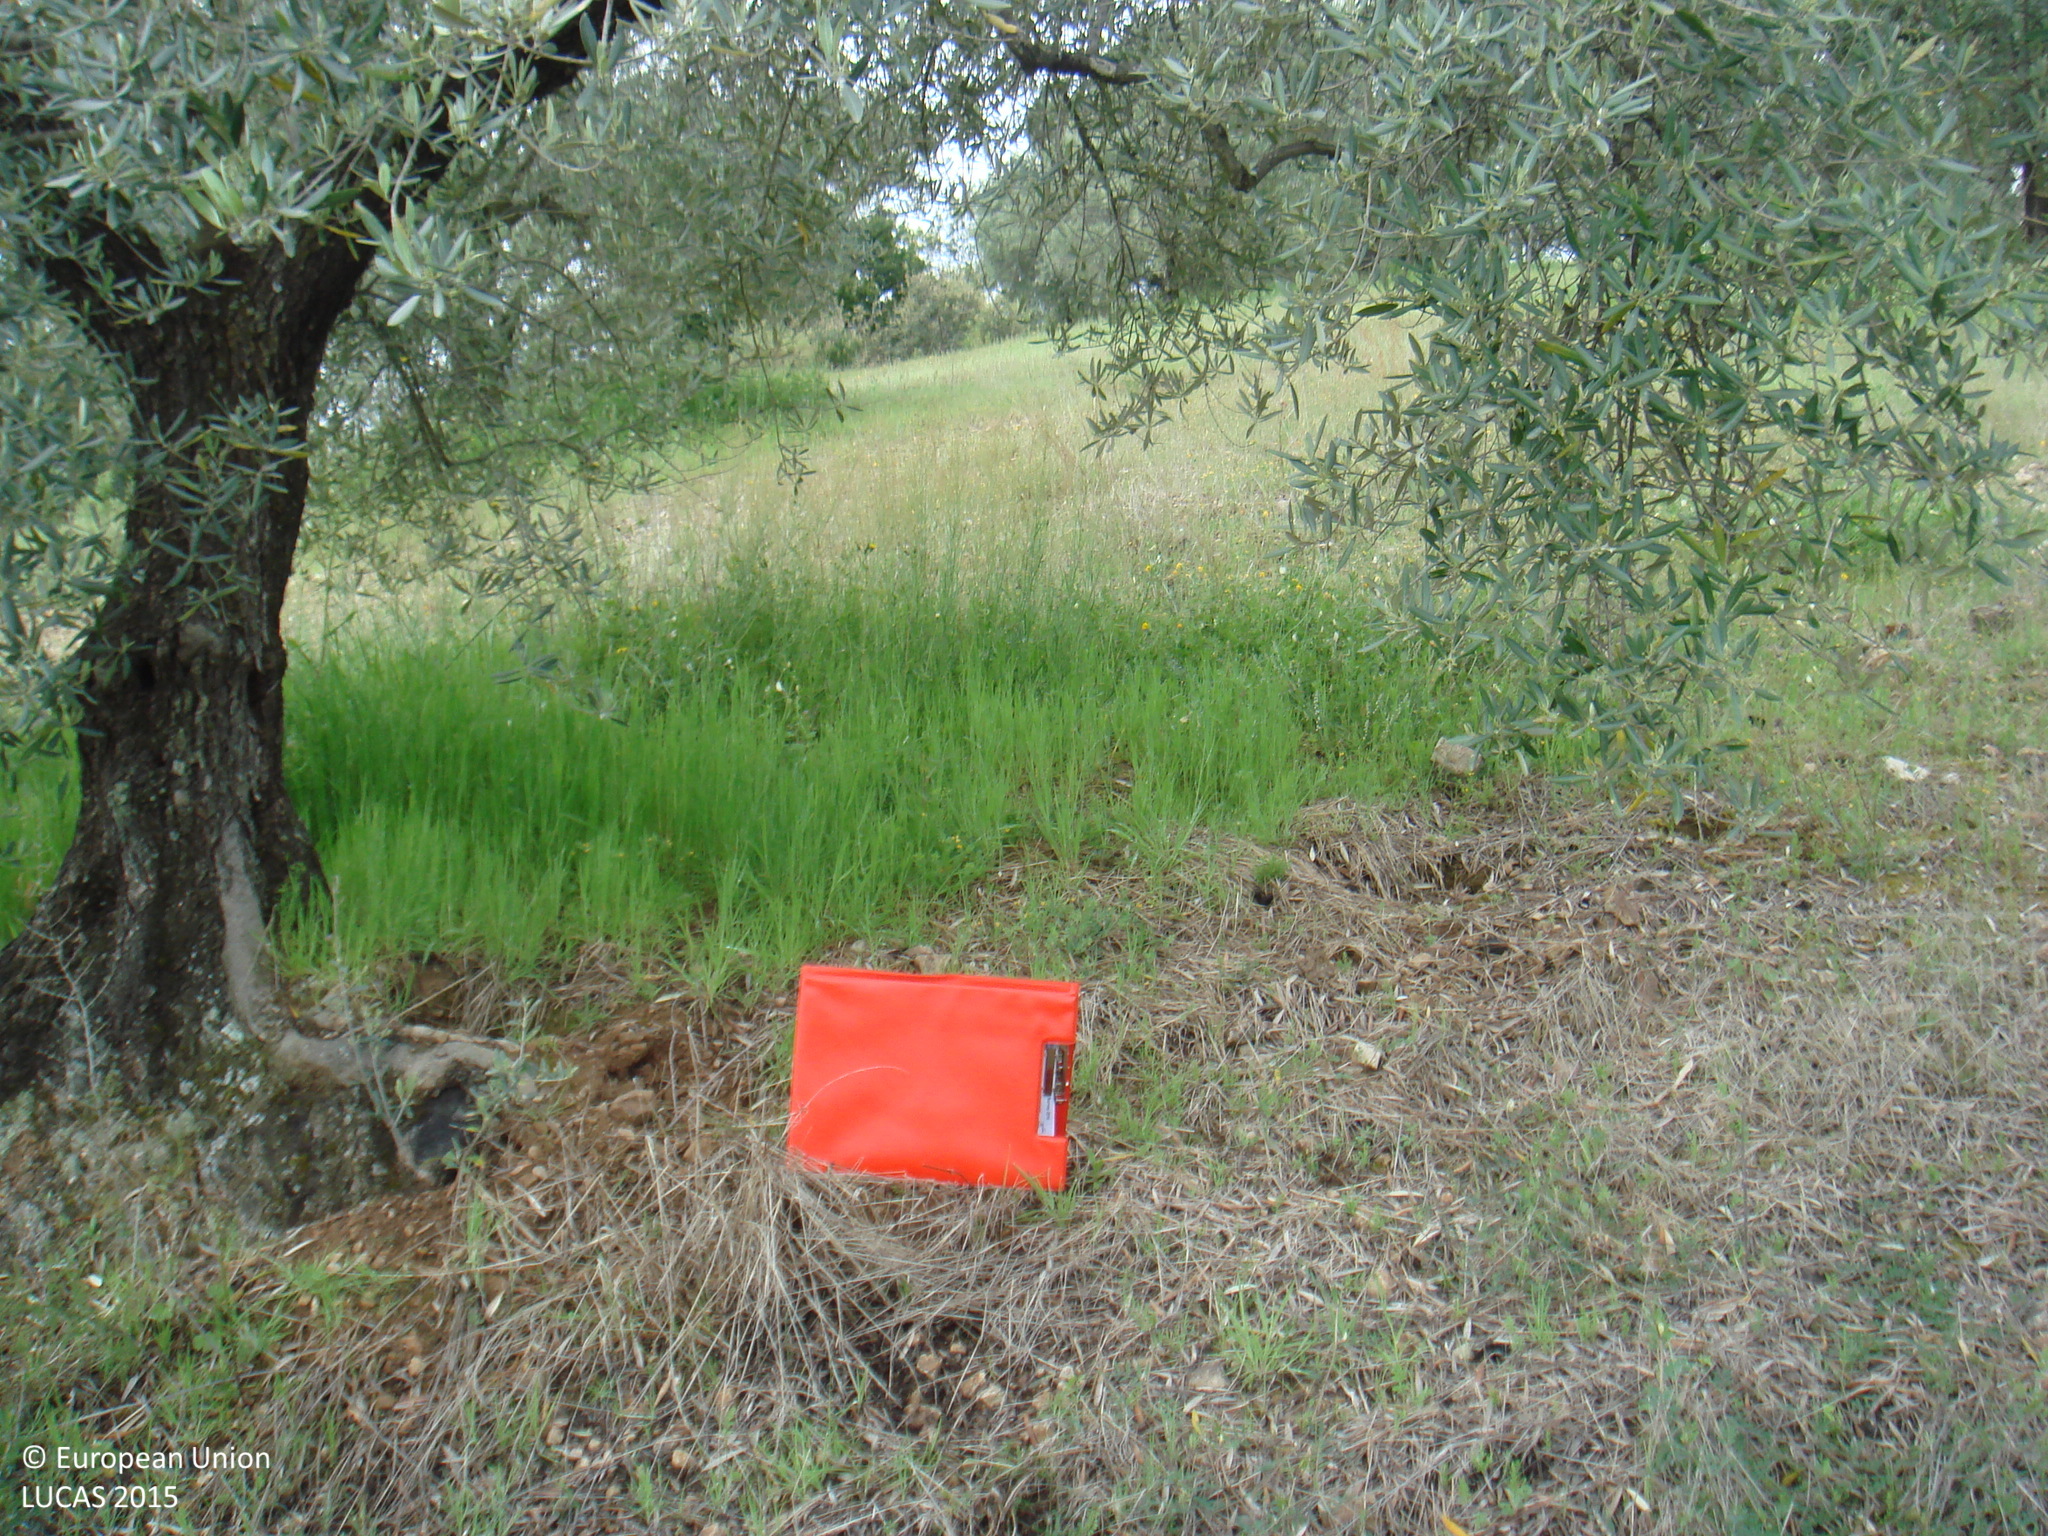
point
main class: Cropland
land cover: Olive groves
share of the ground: 10 - 25 %
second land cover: Spontaneously vegetated surfaces
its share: > 75 %
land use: Agriculture (excluding fallow land and kitchen gardens)
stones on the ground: 10 - 25 %
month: April
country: ES
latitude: 38.0793
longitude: -4.9891
